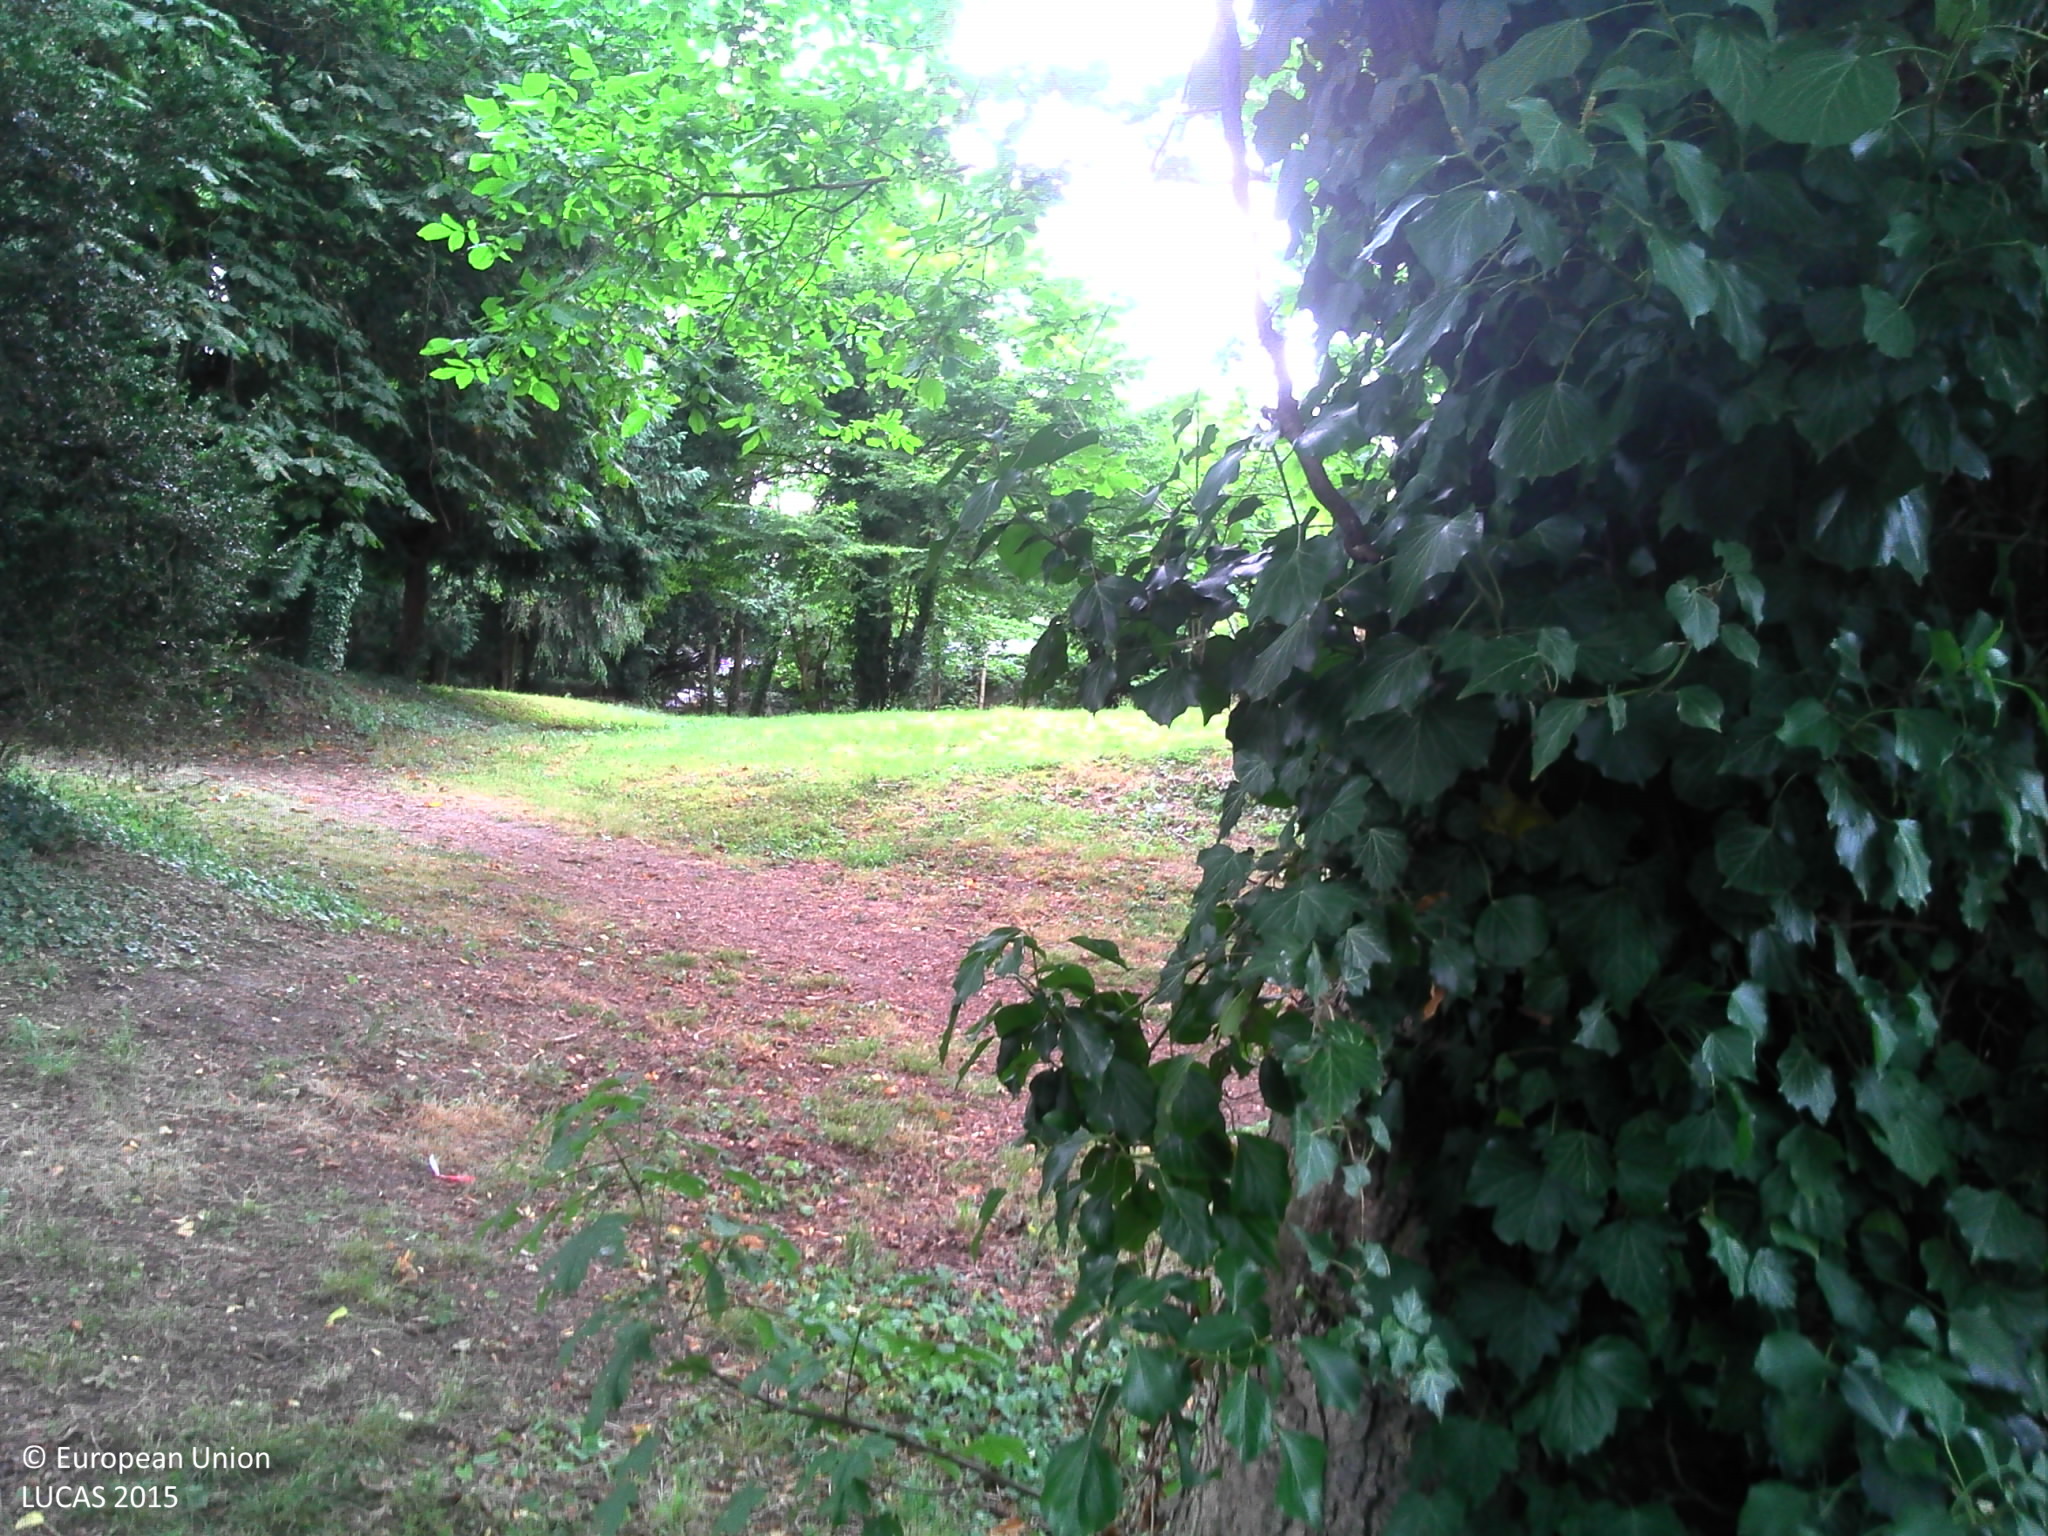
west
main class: Woodland
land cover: Other mixed woodland
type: exotic forest
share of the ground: > 75 %
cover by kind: coniferous forest trees 55 %, broadleaved forest trees 20 %, herbaceous plants 20 %, lichens and mosses 5 %
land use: Amenities, museums, leisure
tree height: > 5 m
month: July
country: FR
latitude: 47.2873
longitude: 0.7125
